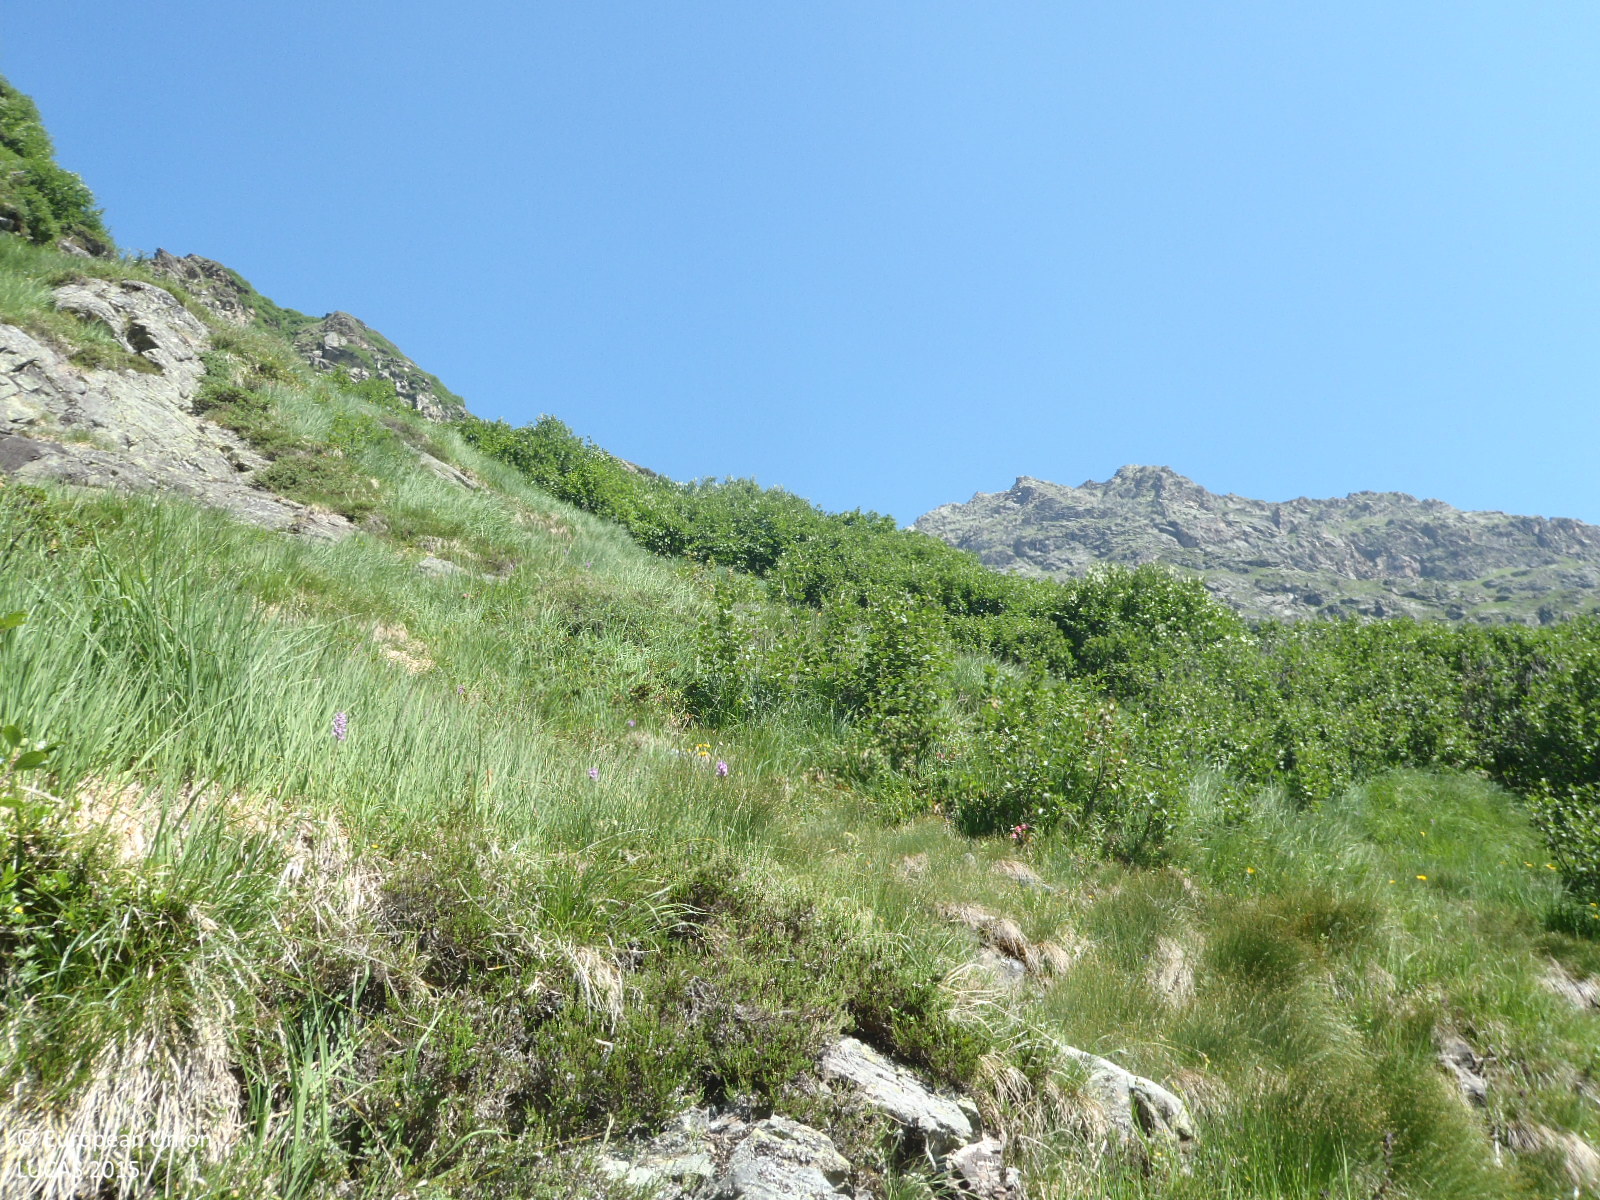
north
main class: Shrubland
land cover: Shrubland without tree cover
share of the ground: 50 - 75 %
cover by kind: shrubs 75 %, herbaceous plants 25 %
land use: Semi-natural and natural areas not in use
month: July
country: AT
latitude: 46.9274
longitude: 10.1181
